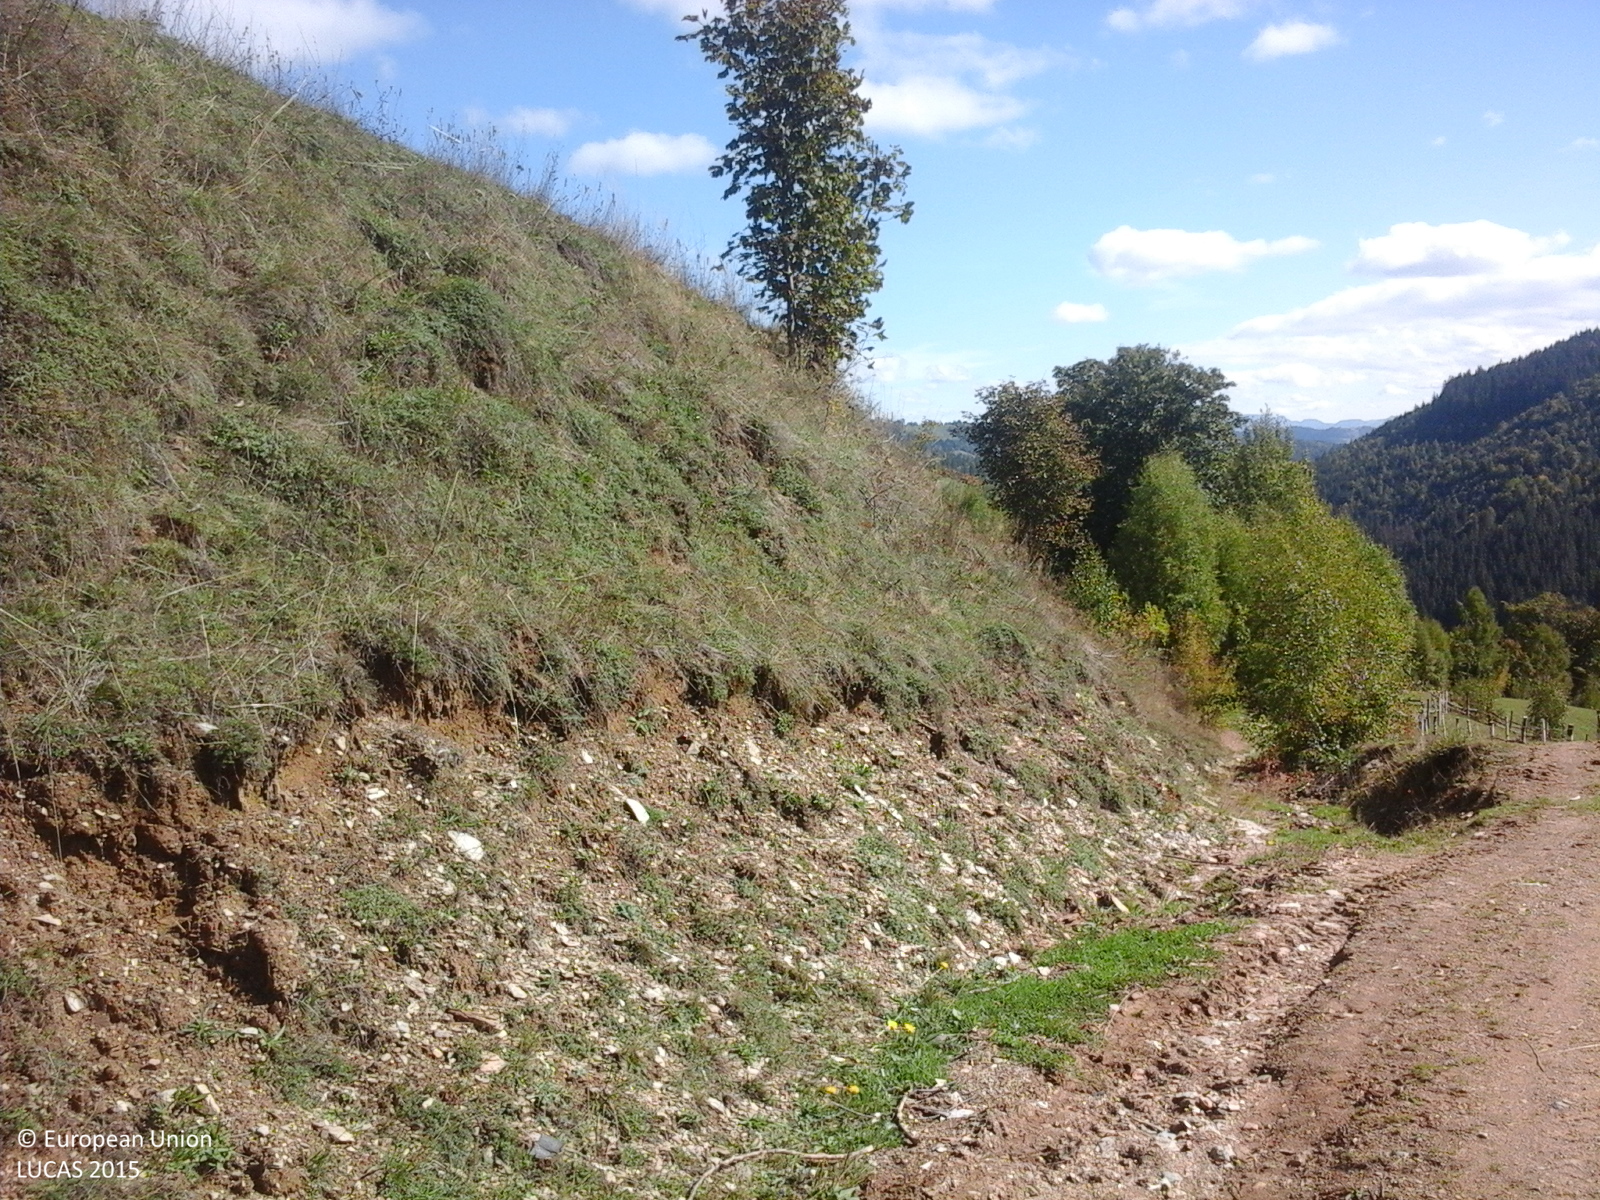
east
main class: Grassland
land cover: Grassland without tree/shrub cover
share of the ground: > 75 %
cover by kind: herbaceous plants 100 %
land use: Agriculture (excluding fallow land and kitchen gardens)
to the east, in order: Grass margins; Tracks; Grassland without tree/shrub cover; Electric lines; Grassland without tree/shrub cover; Broadleaved woodland; Grassland without tree/shrub cover; Broadleaved woodland
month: October
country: RO
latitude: 46.4230
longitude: 22.8999
